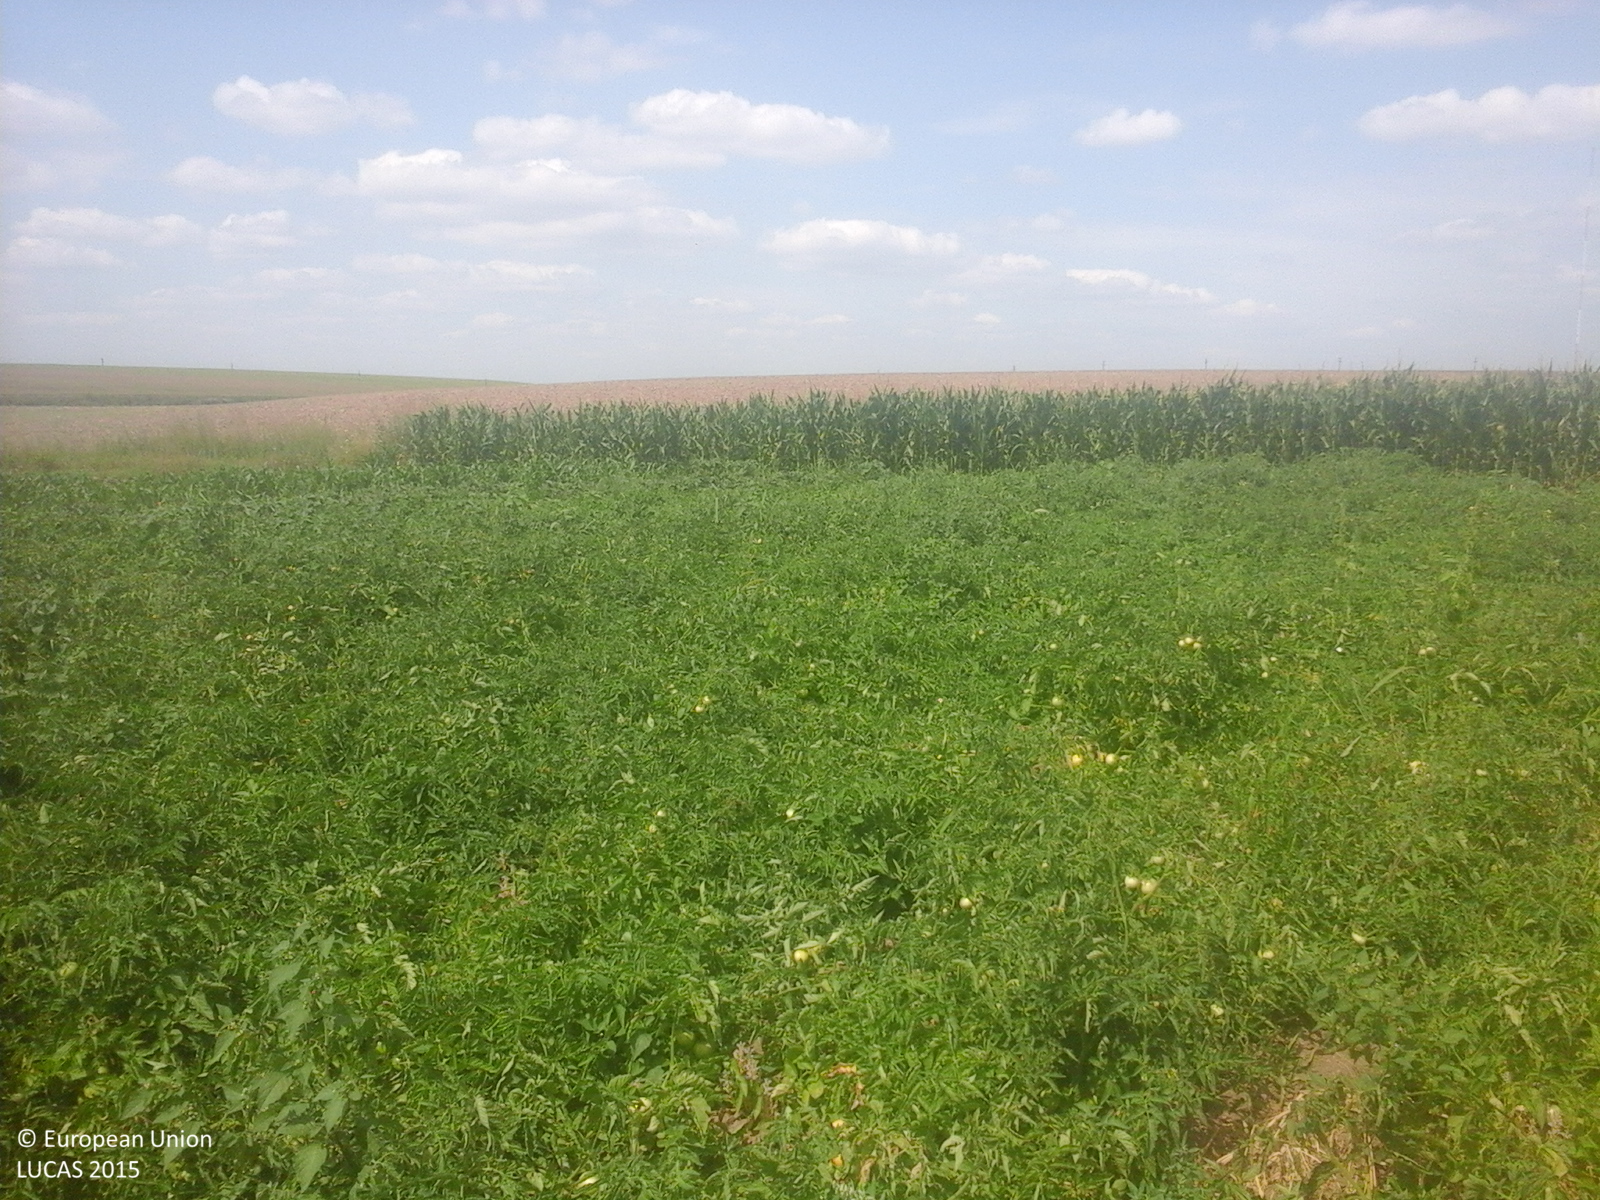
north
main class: Cropland
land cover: Tomatoes
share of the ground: > 75 %
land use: Agriculture (excluding fallow land and kitchen gardens)
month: August
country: RO
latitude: 44.6681
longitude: 28.2683
